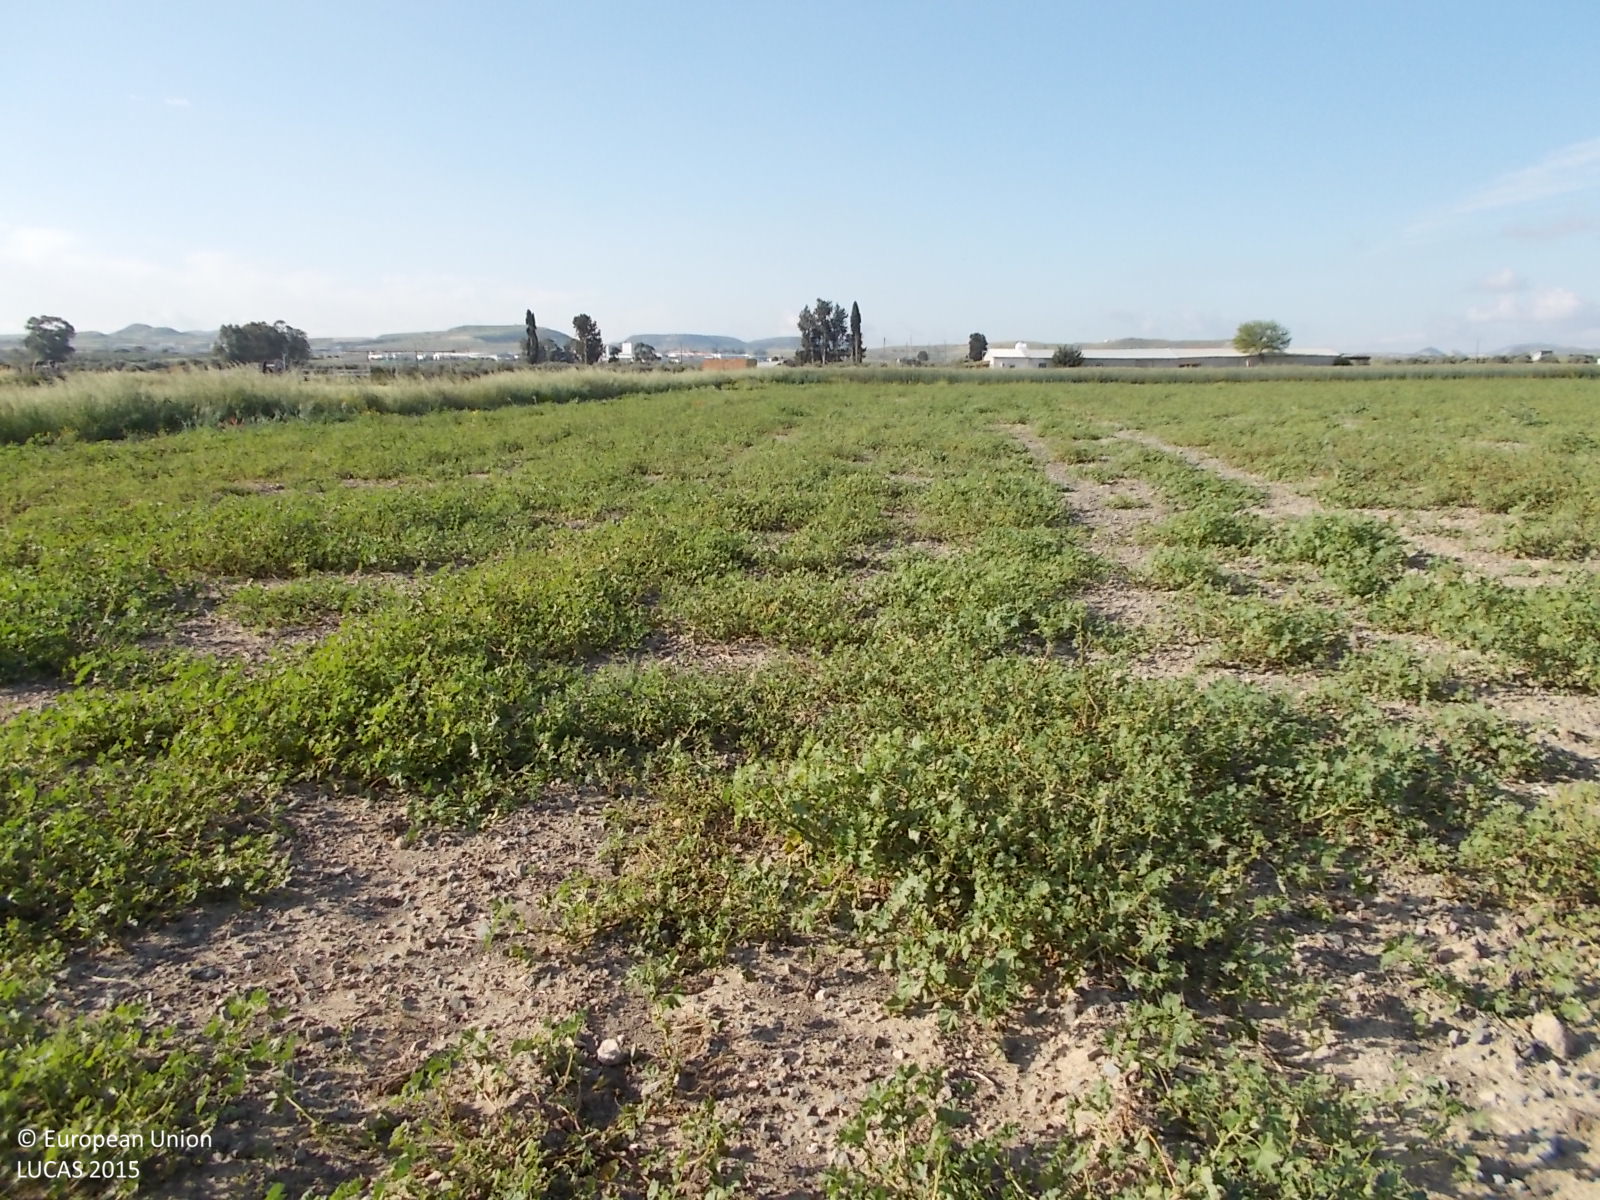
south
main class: Cropland
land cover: Other fresh vegetables
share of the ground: 50 - 75 %
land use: Agriculture (excluding fallow land and kitchen gardens)
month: April
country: CY
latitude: 35.0717
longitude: 33.5227
